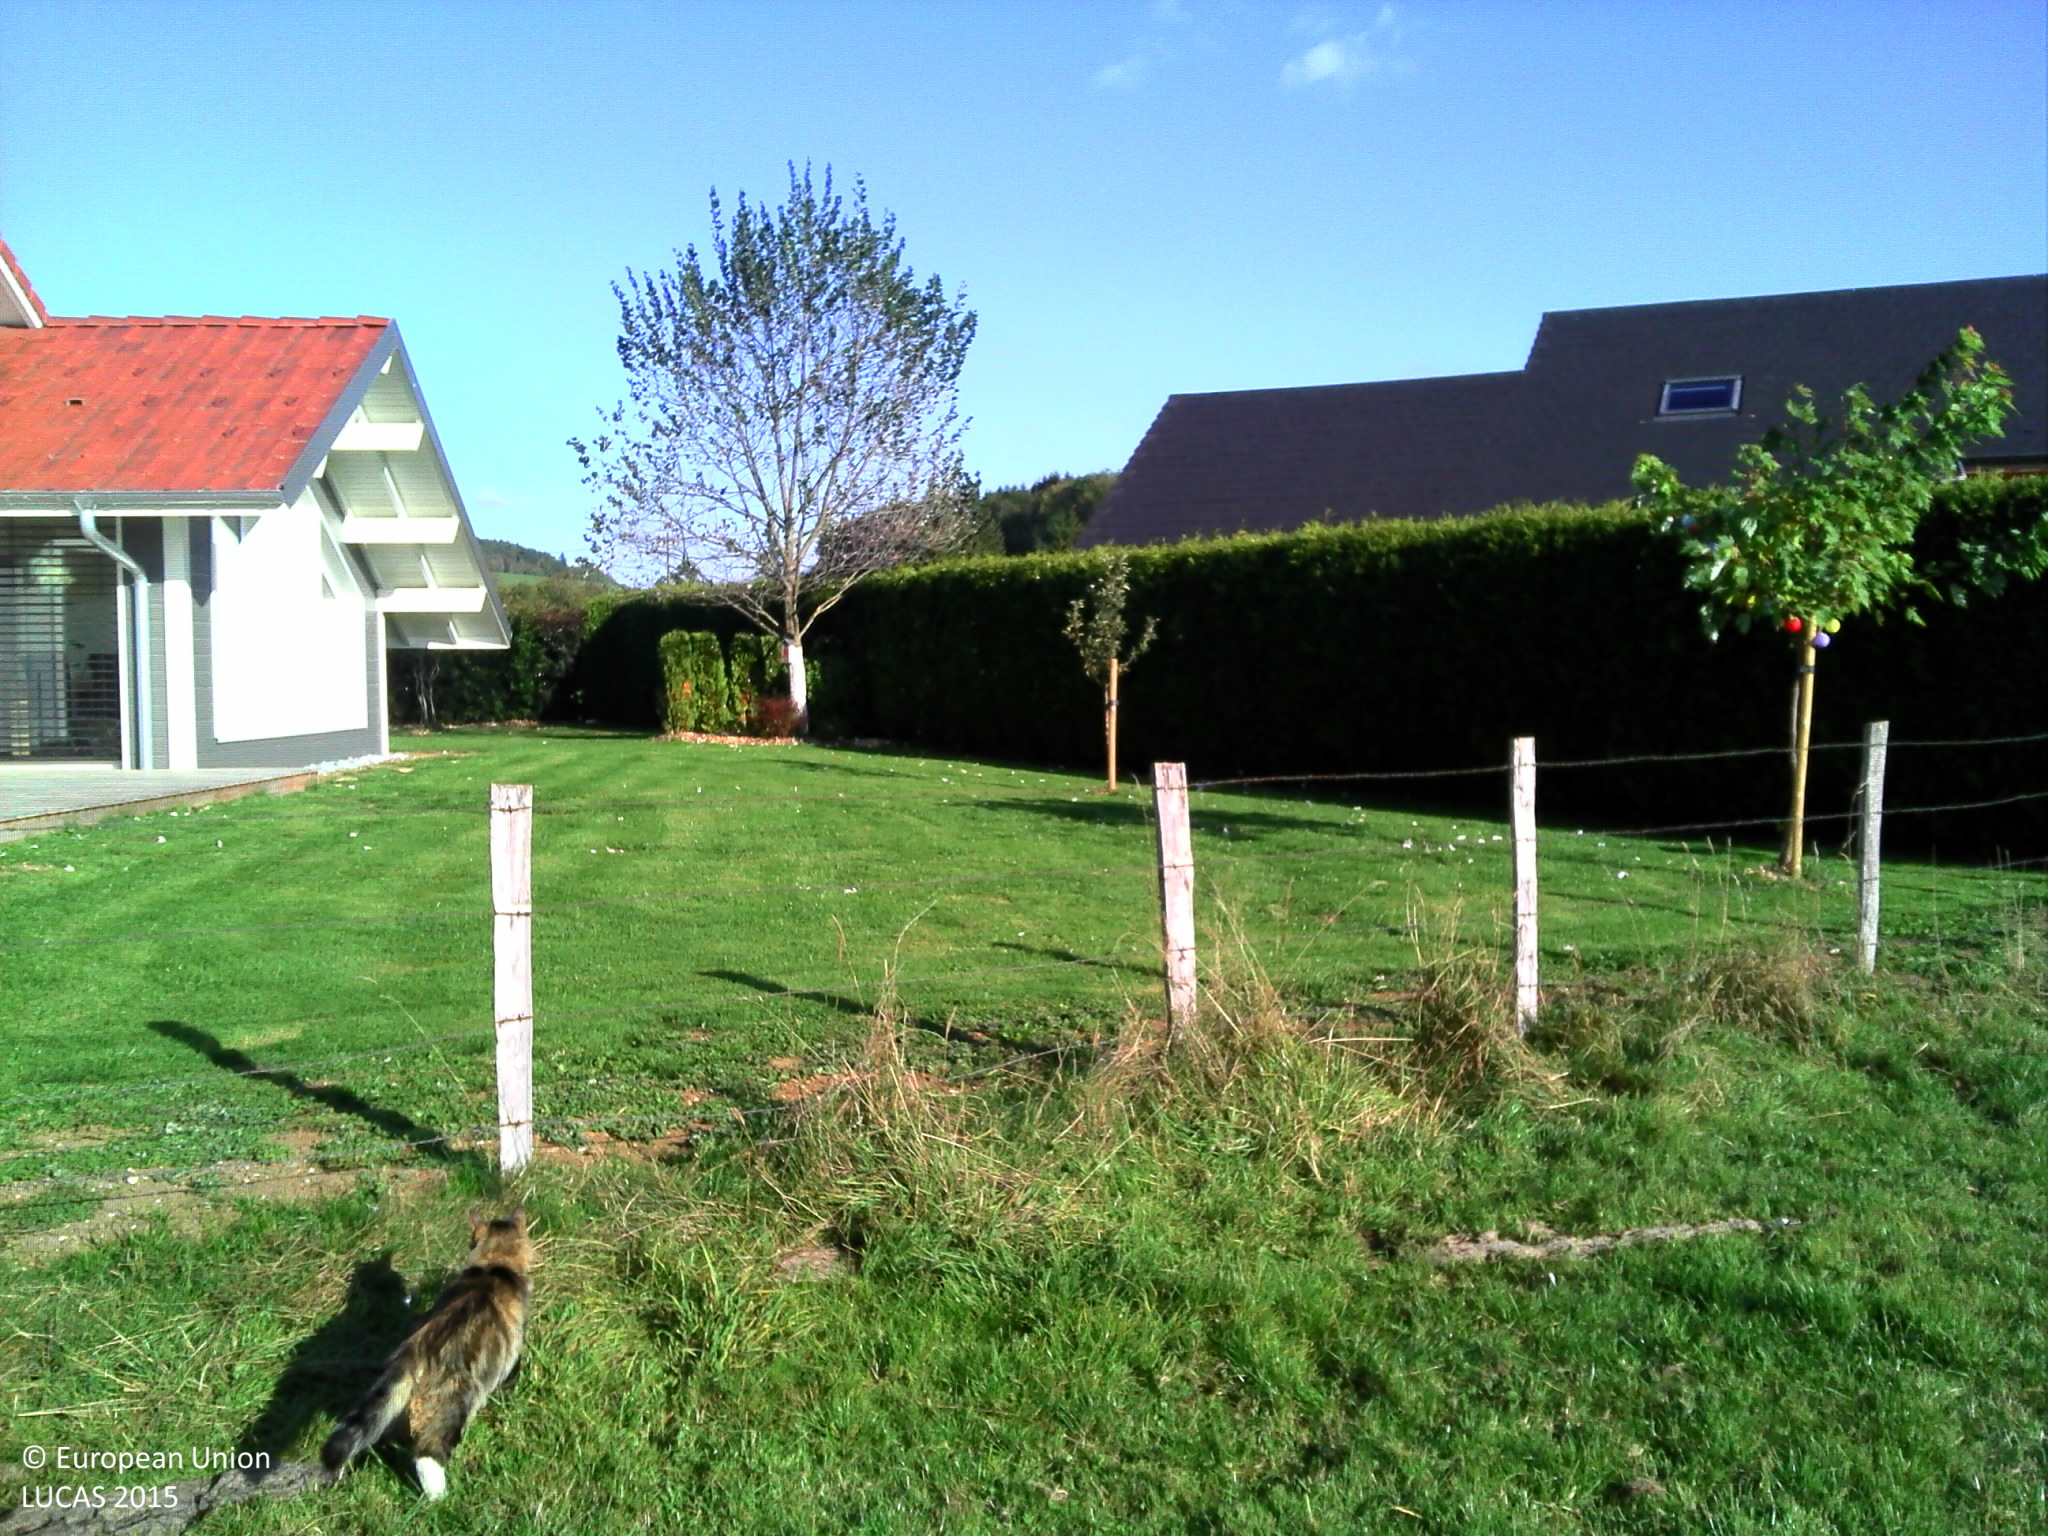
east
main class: Grassland
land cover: Grassland without tree/shrub cover
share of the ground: > 75 %
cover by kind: herbaceous plants 100 %
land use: Agriculture (excluding fallow land and kitchen gardens)
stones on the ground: < 10 %
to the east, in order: Grassland without tree/shrub cover; Fences; Grassland without tree/shrub cover; Artificial constructions in urban areas; Dry stone walls; Broadleaved woodland; Fences; Grassland without tree/shrub cover
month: September
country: FR
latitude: 47.2785
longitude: 6.8689
